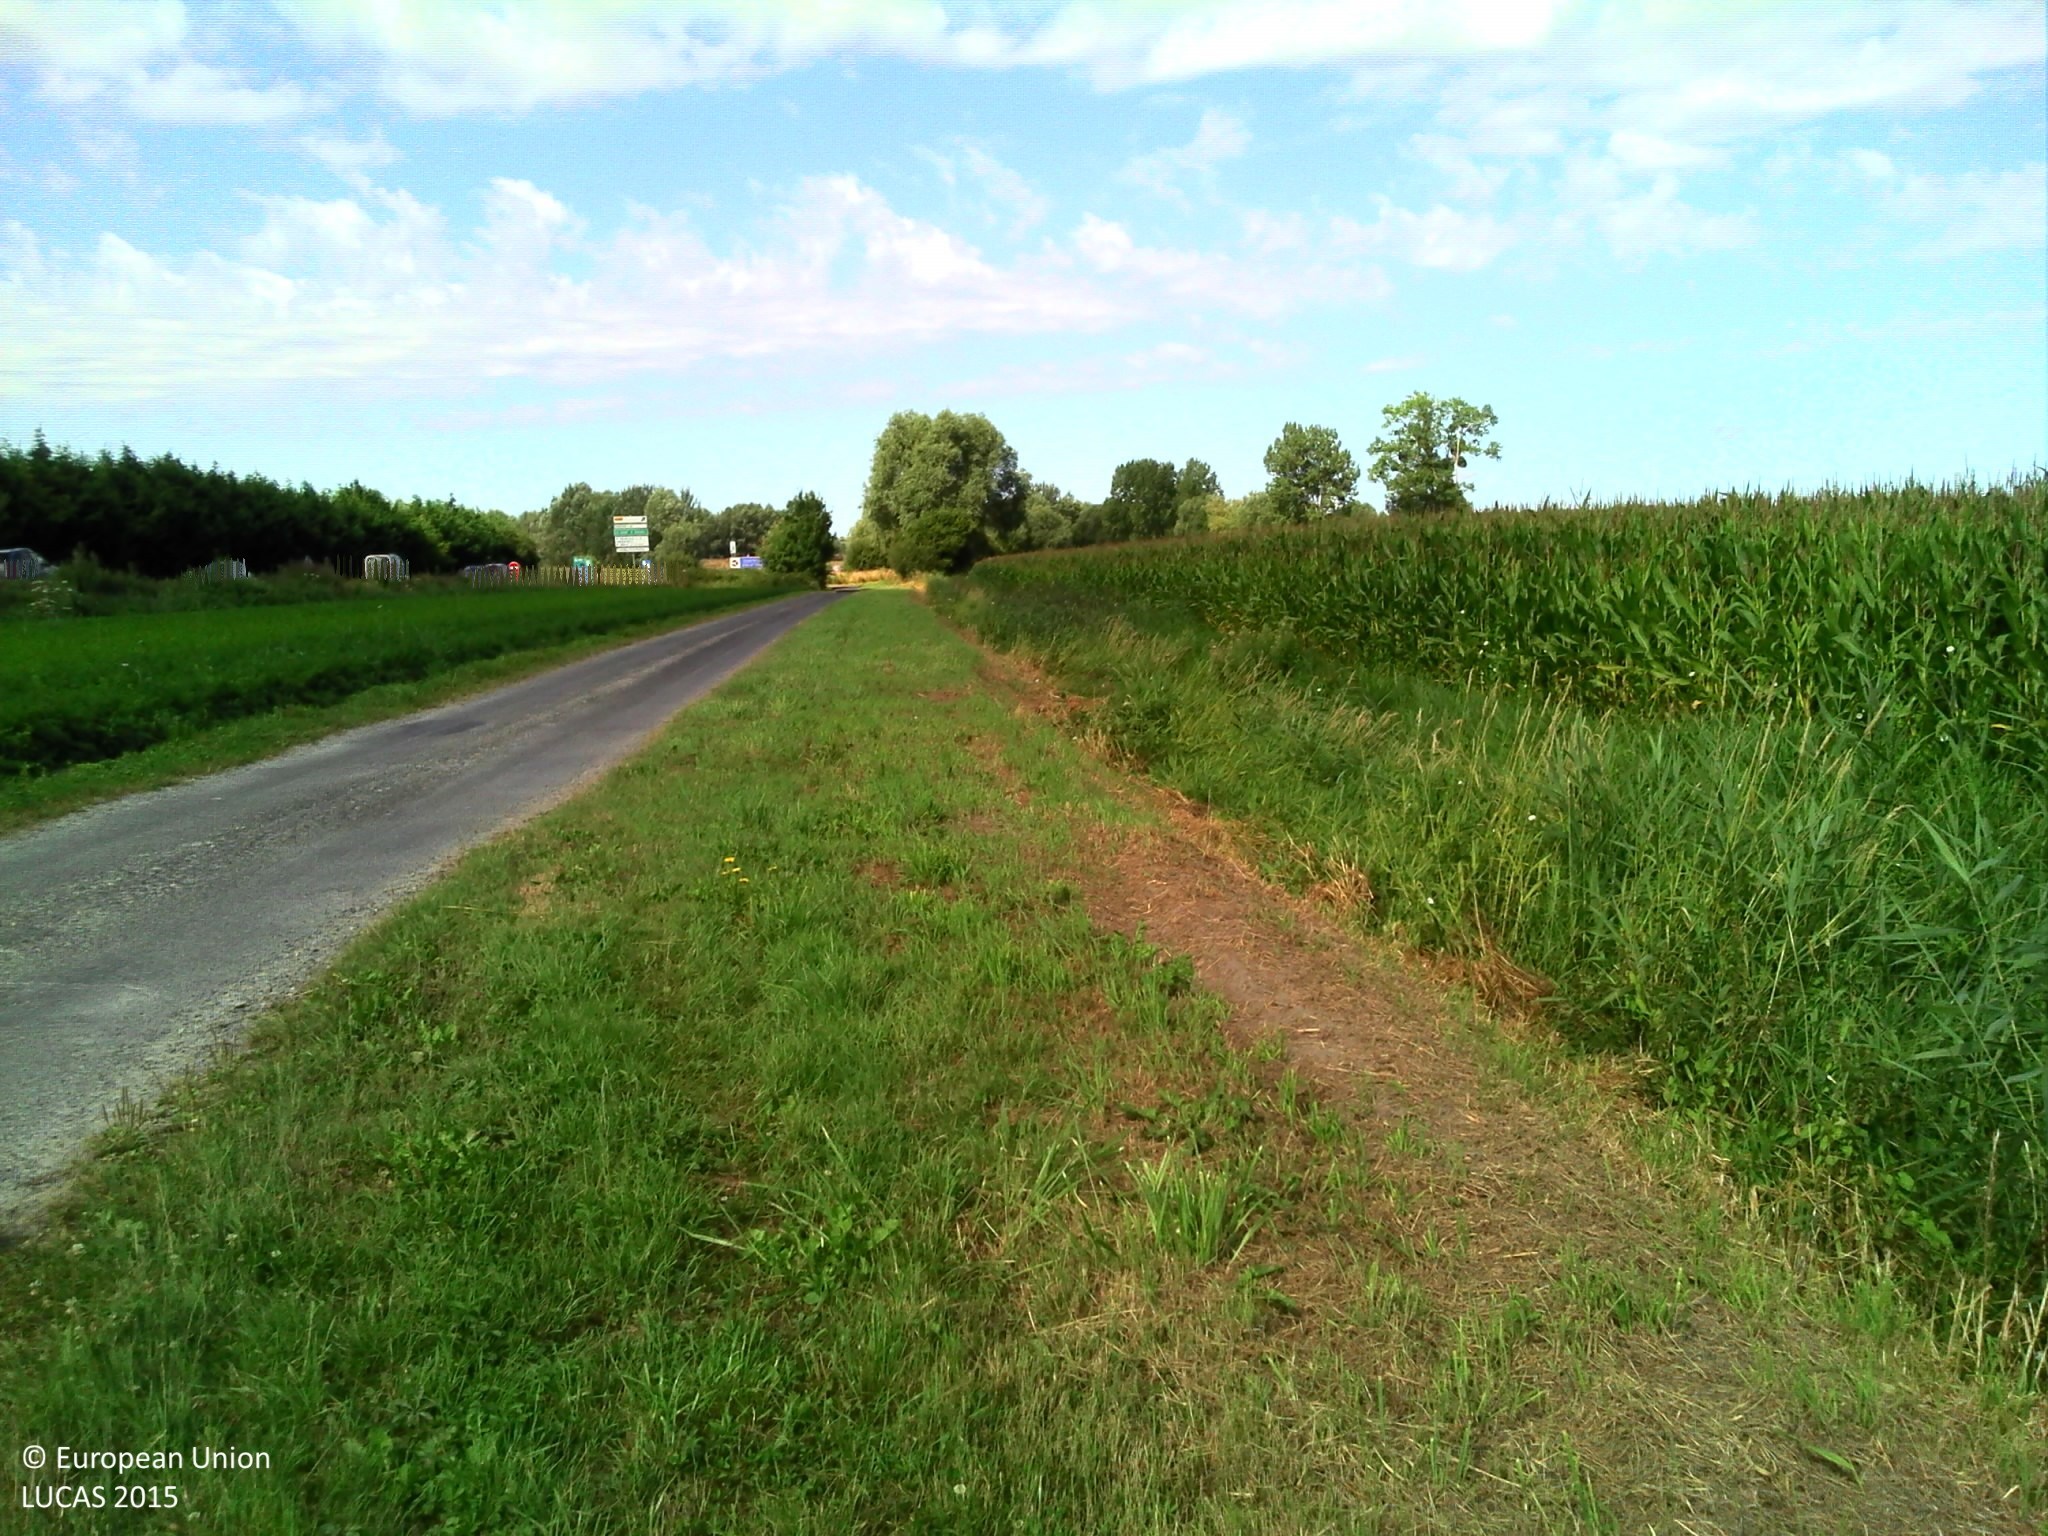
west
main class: Grassland
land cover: Grassland without tree/shrub cover
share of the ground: > 75 %
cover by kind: herbaceous plants 100 %
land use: Road transport
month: August
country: FR
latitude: 48.5619
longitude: -1.5246
